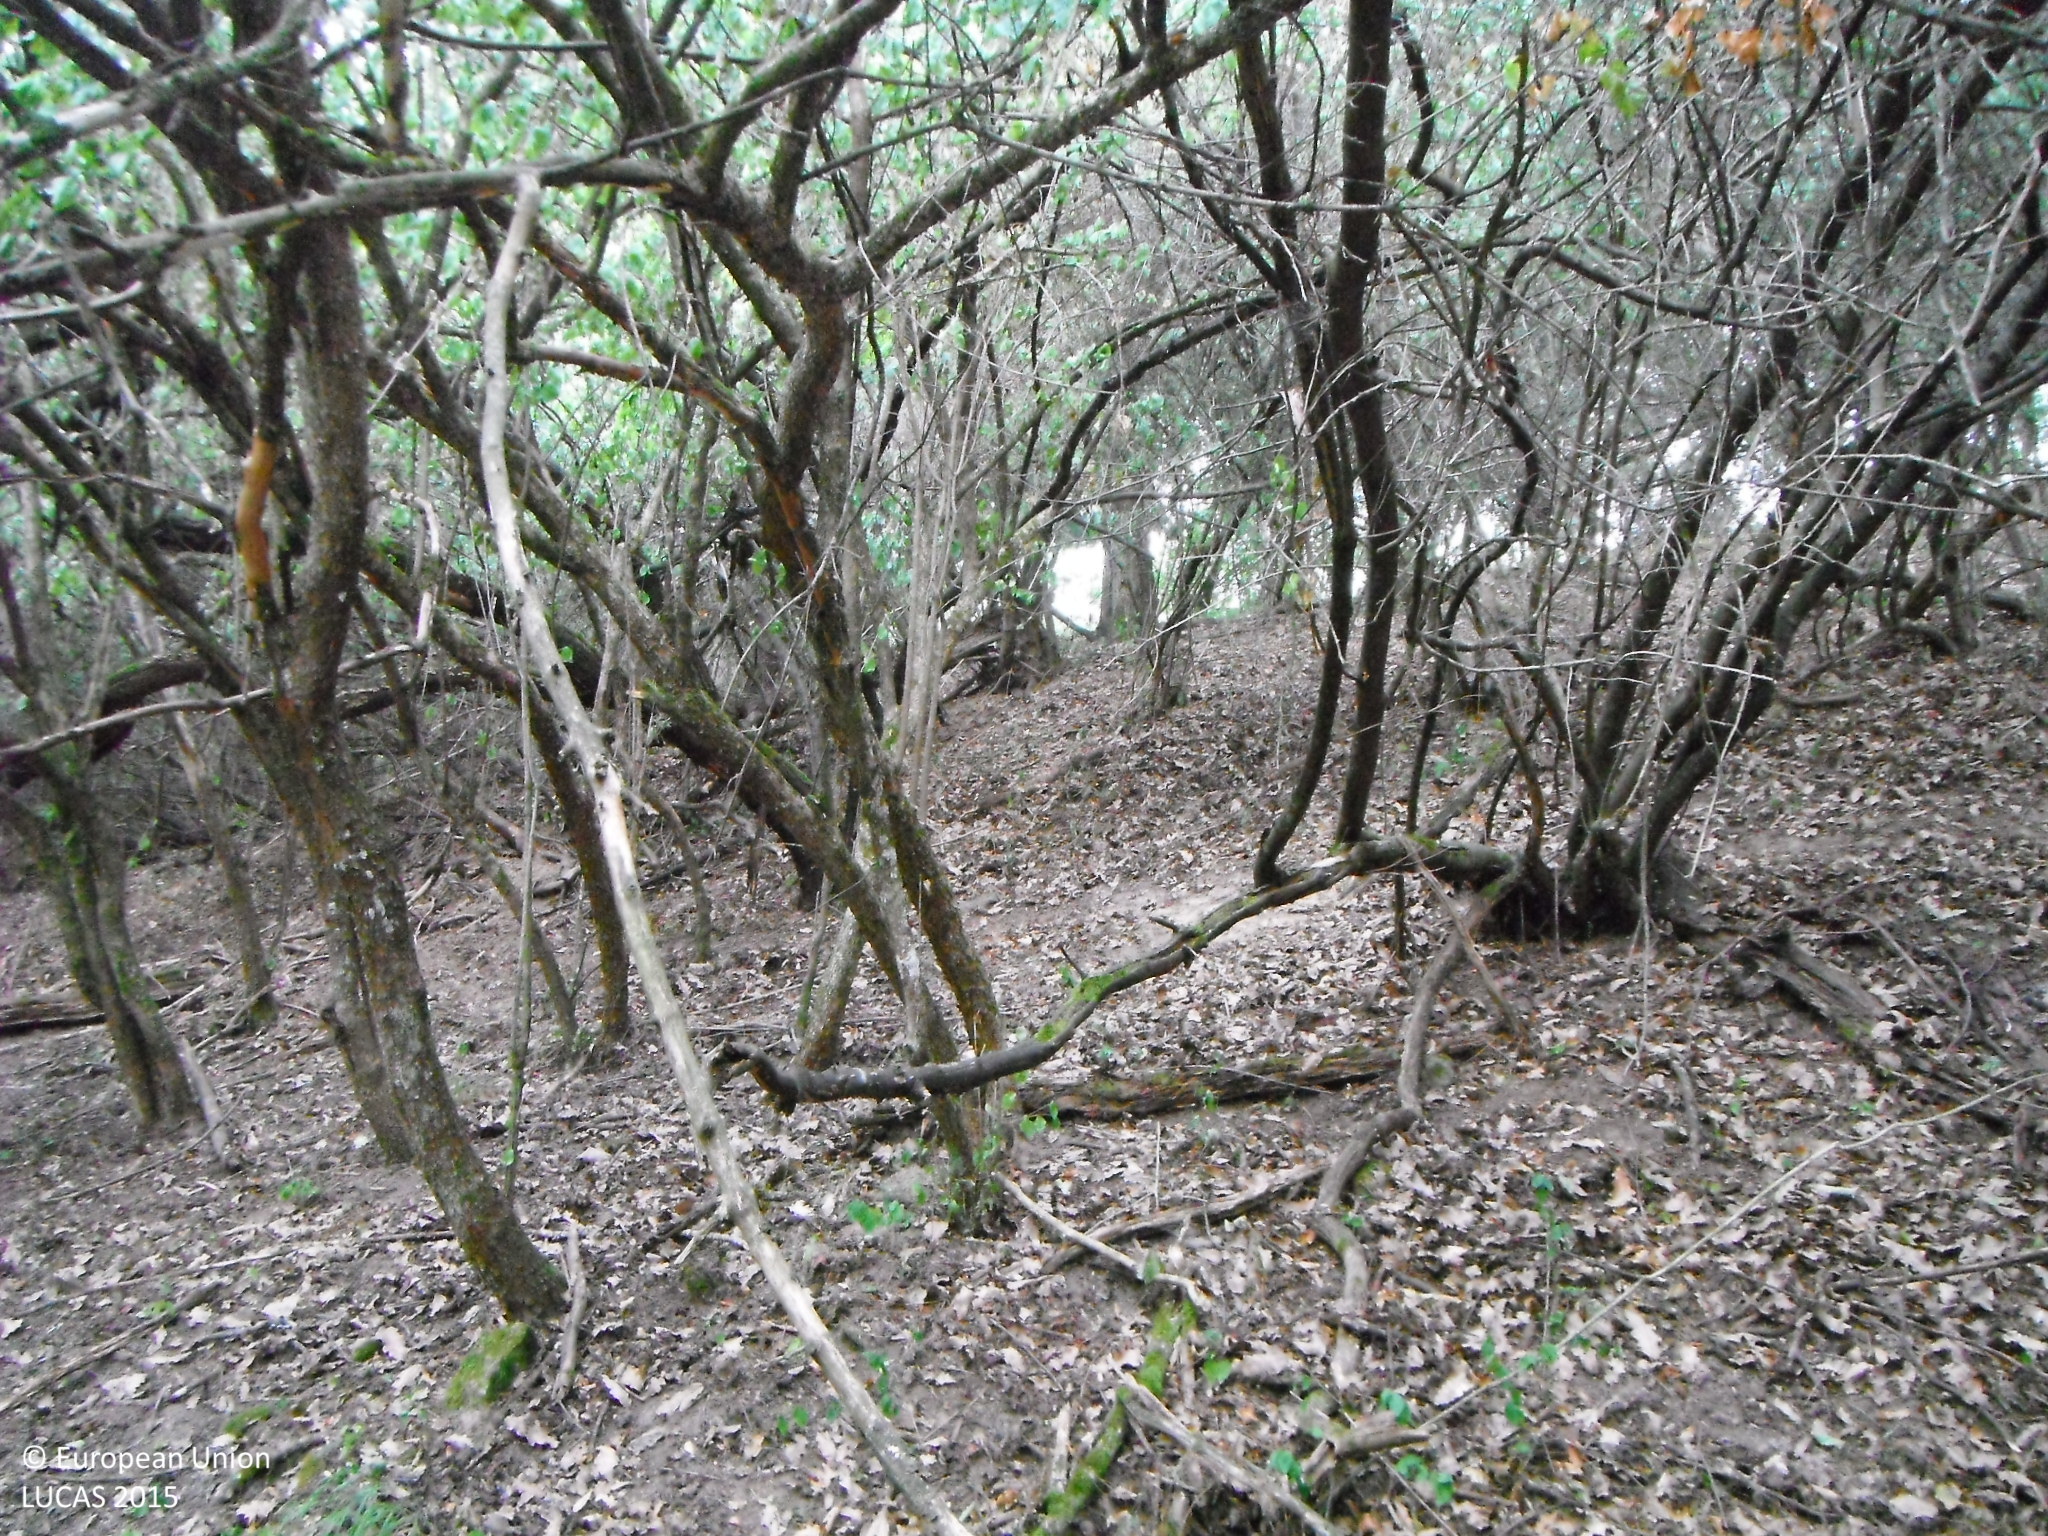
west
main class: Woodland
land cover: Broadleaved woodland
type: mesophytic deciduous forest
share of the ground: > 75 %
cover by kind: broadleaved forest trees 100 %
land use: Forestry
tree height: > 5 m
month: July
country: SK
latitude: 48.2841
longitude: 19.0633
